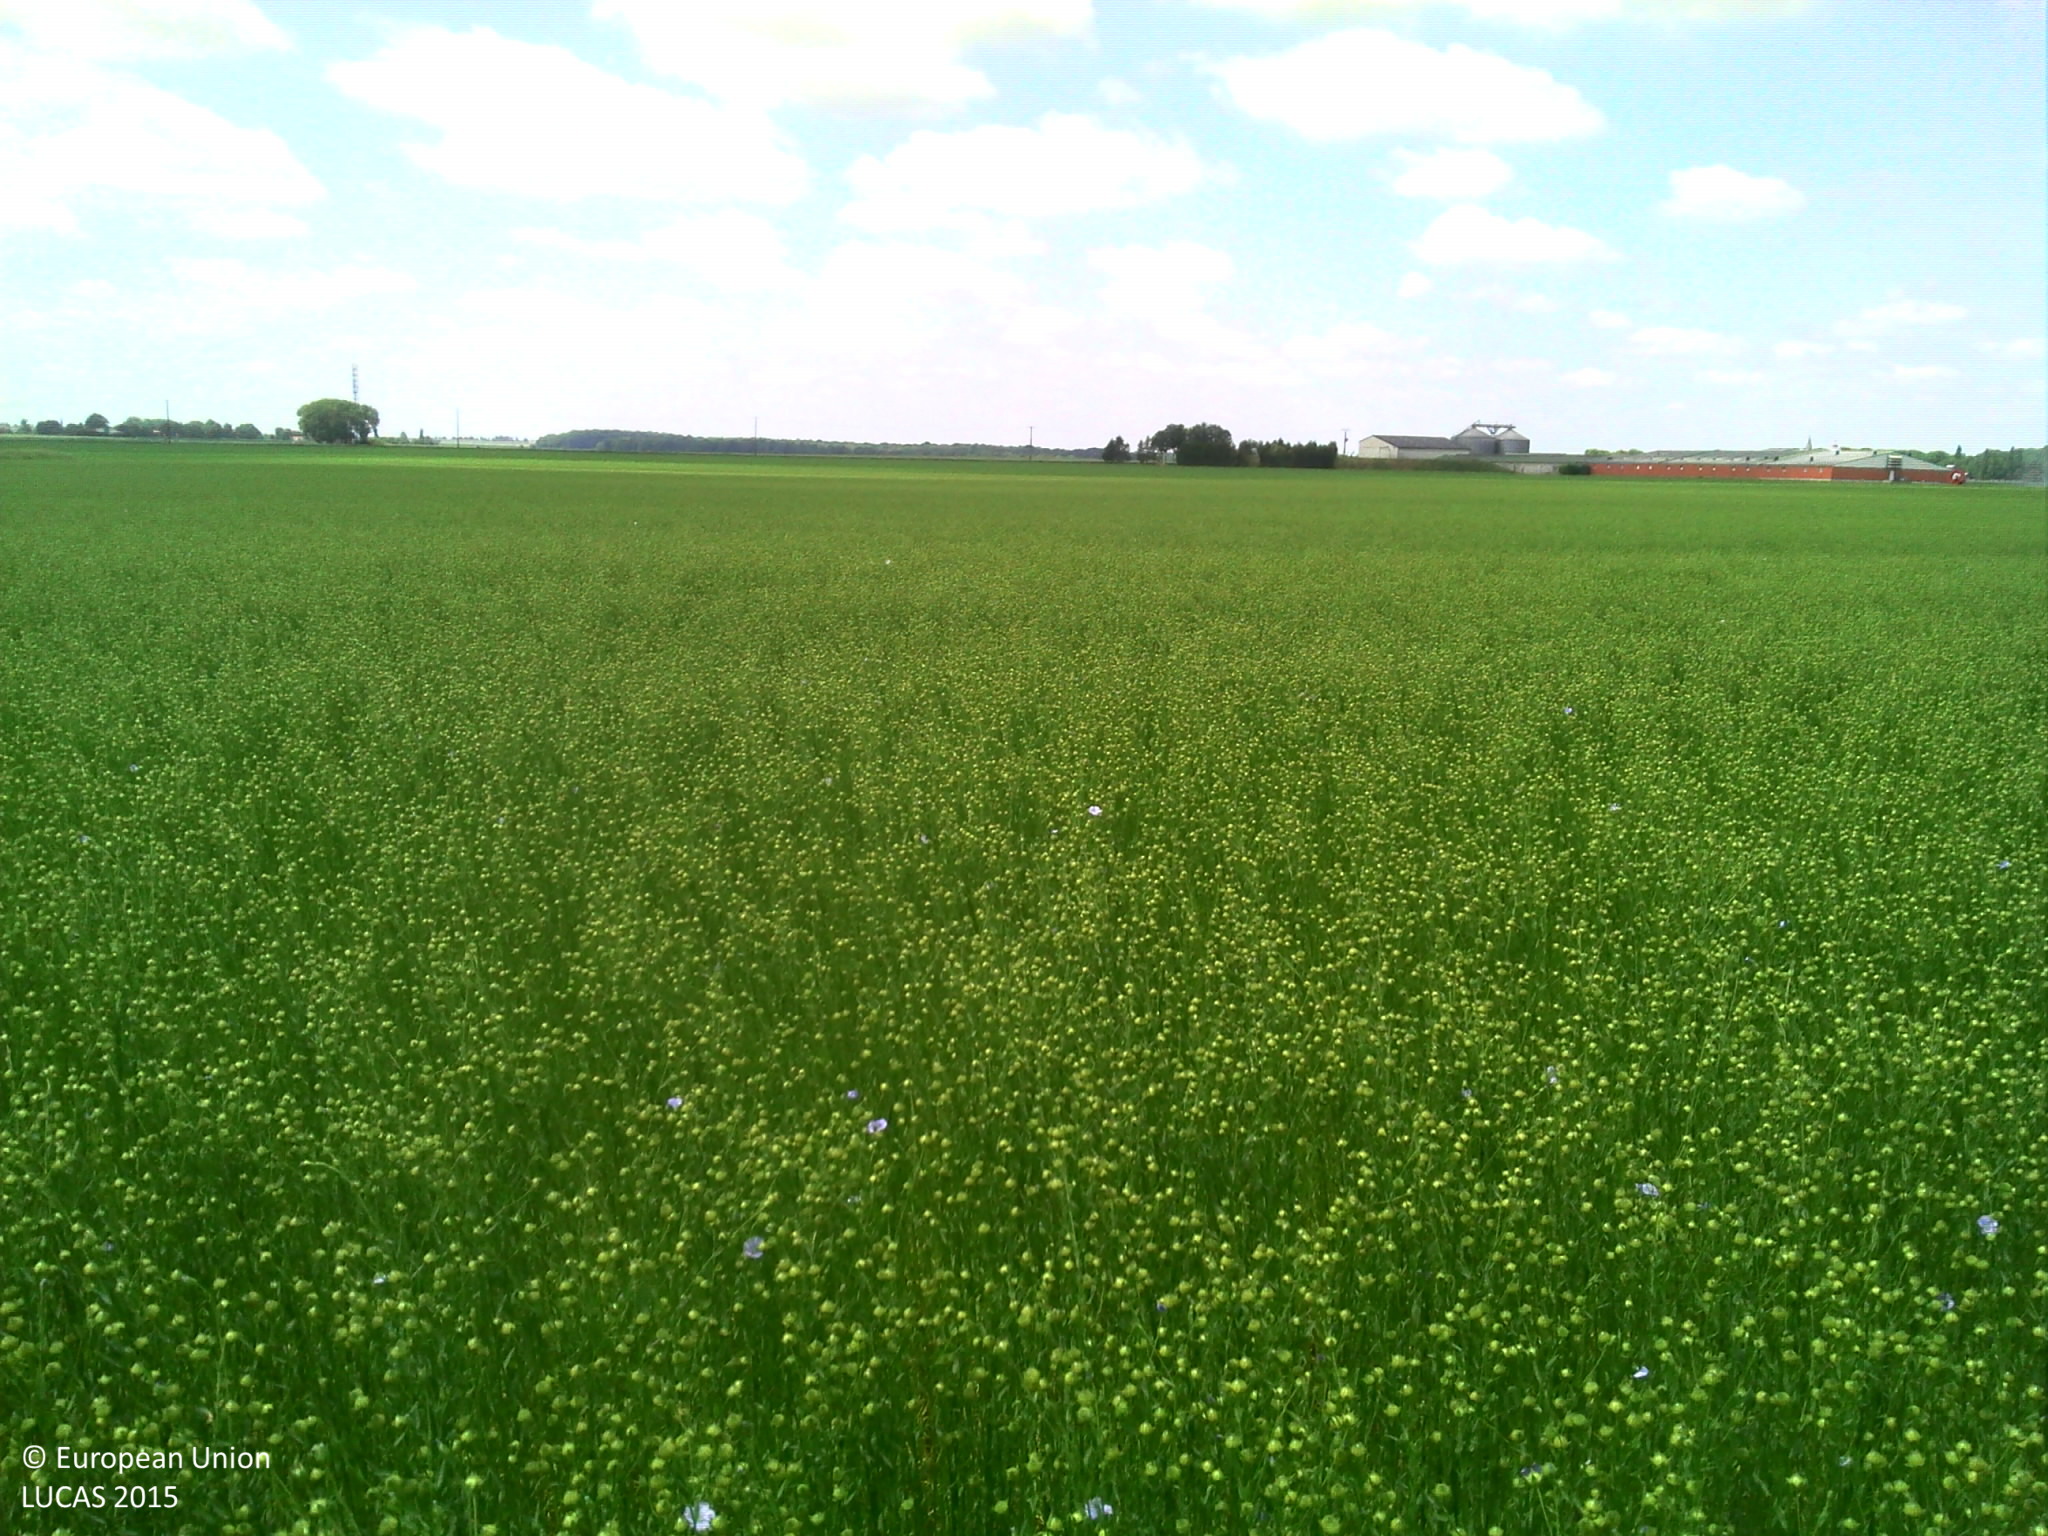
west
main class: Cropland
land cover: Other fibre and oleaginous crops
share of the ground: > 75 %
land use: Agriculture (excluding fallow land and kitchen gardens)
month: June
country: FR
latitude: 49.6835
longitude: 2.4895
